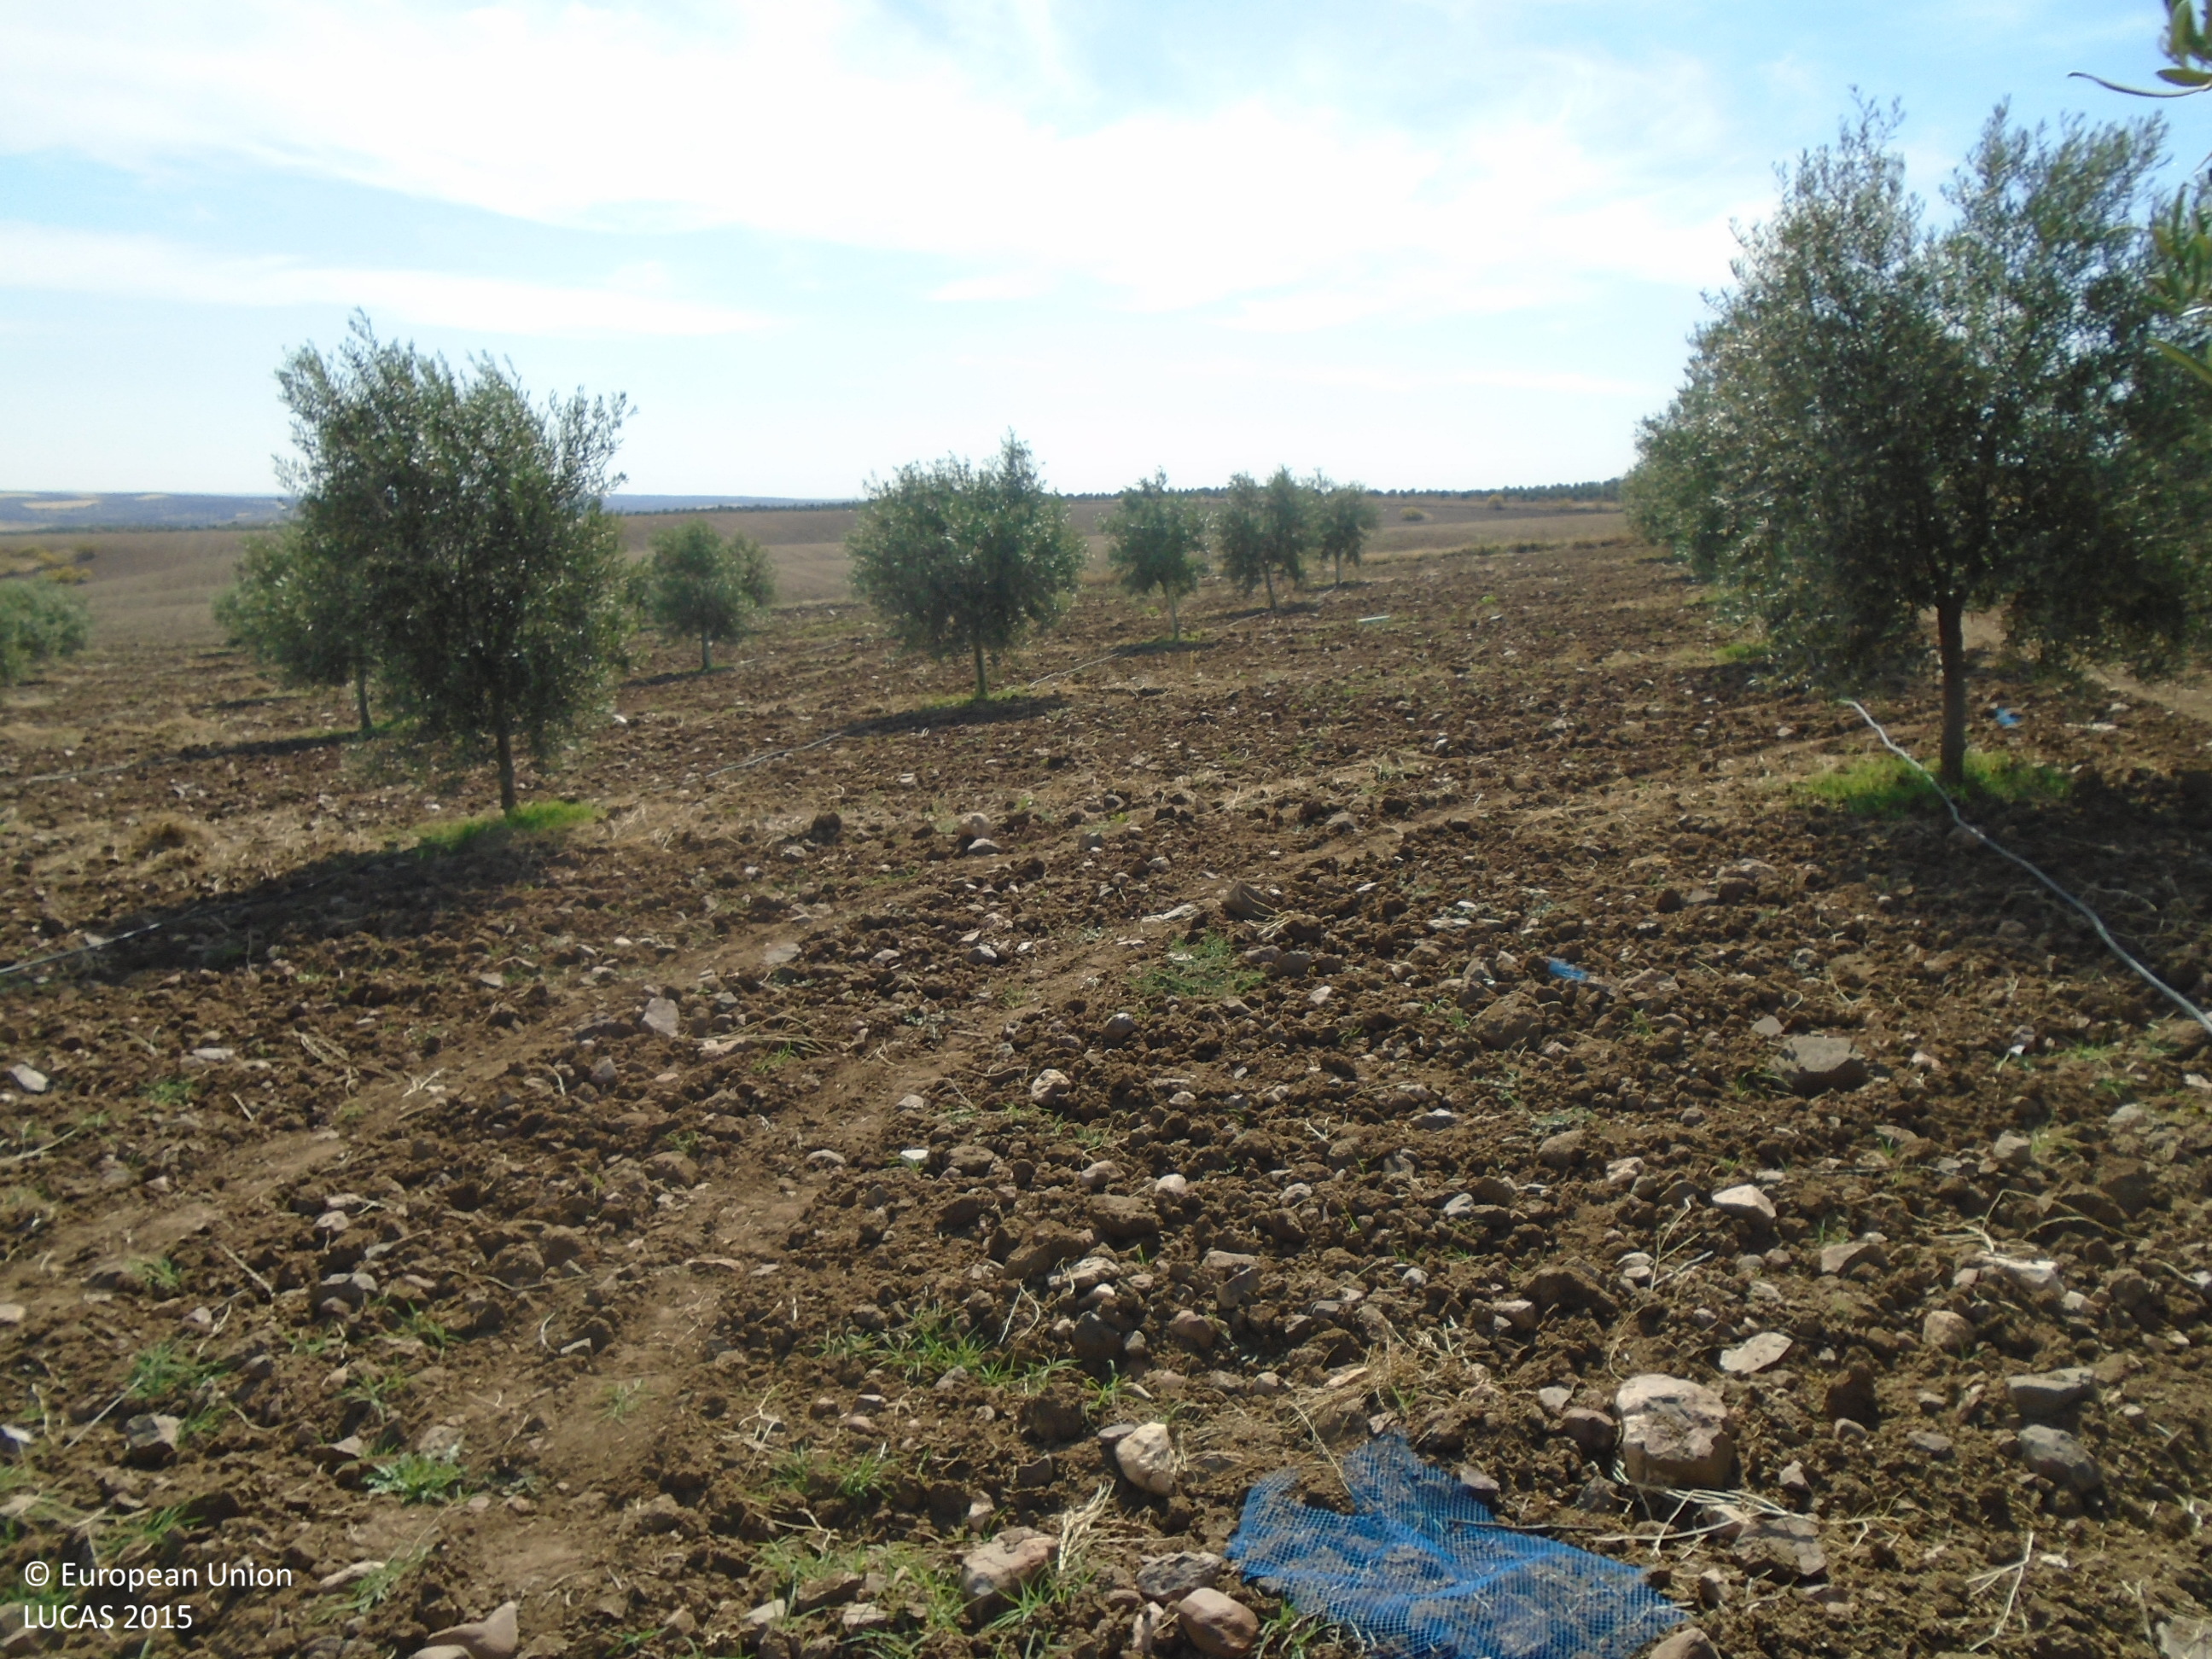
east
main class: Cropland
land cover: Olive groves
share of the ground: 10 - 25 %
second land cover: Other bare soil
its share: > 75 %
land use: Agriculture (excluding fallow land and kitchen gardens)
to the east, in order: Olive groves; Other bare soil; Grass margins; Other bare soil
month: June
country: ES
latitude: 39.8178
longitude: -3.8043
